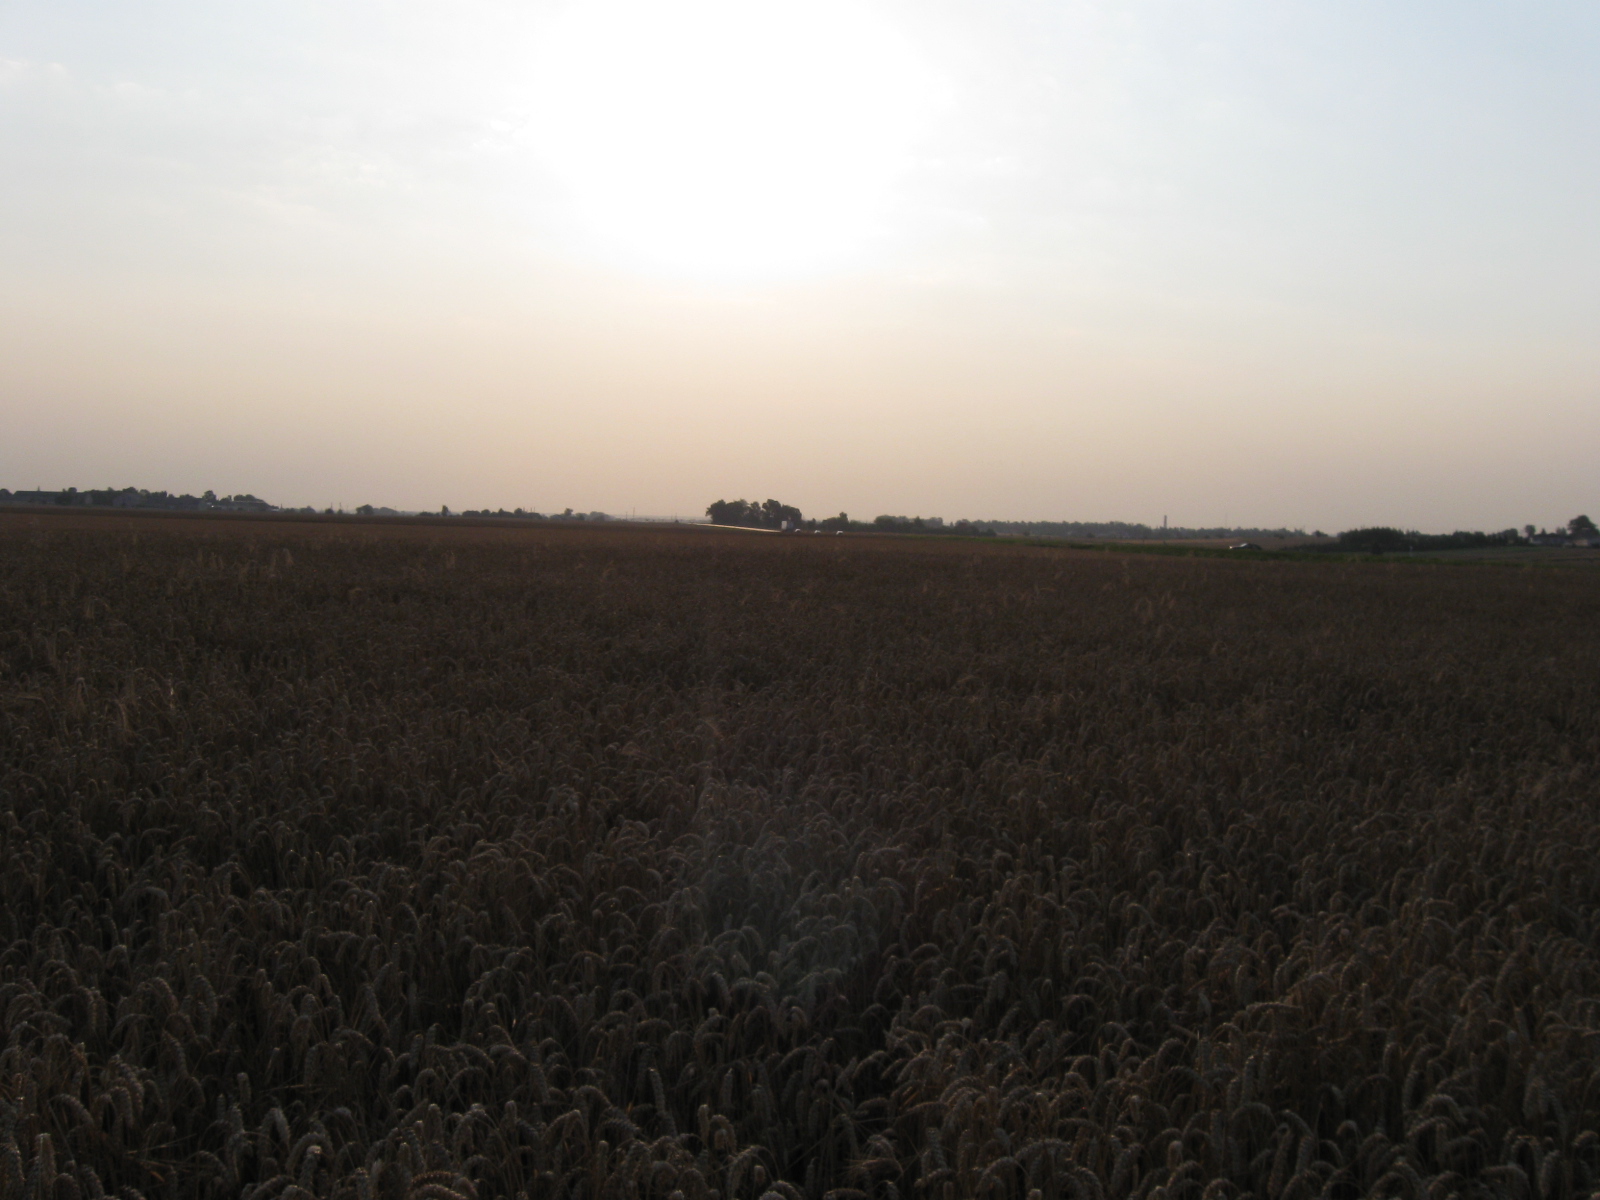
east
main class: Cropland
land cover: Common wheat
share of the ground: > 75 %
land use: Agriculture (excluding fallow land and kitchen gardens)
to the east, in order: Common wheat; Grassland without tree/shrub cover
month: August
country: LT
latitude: 54.5784
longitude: 23.3057
